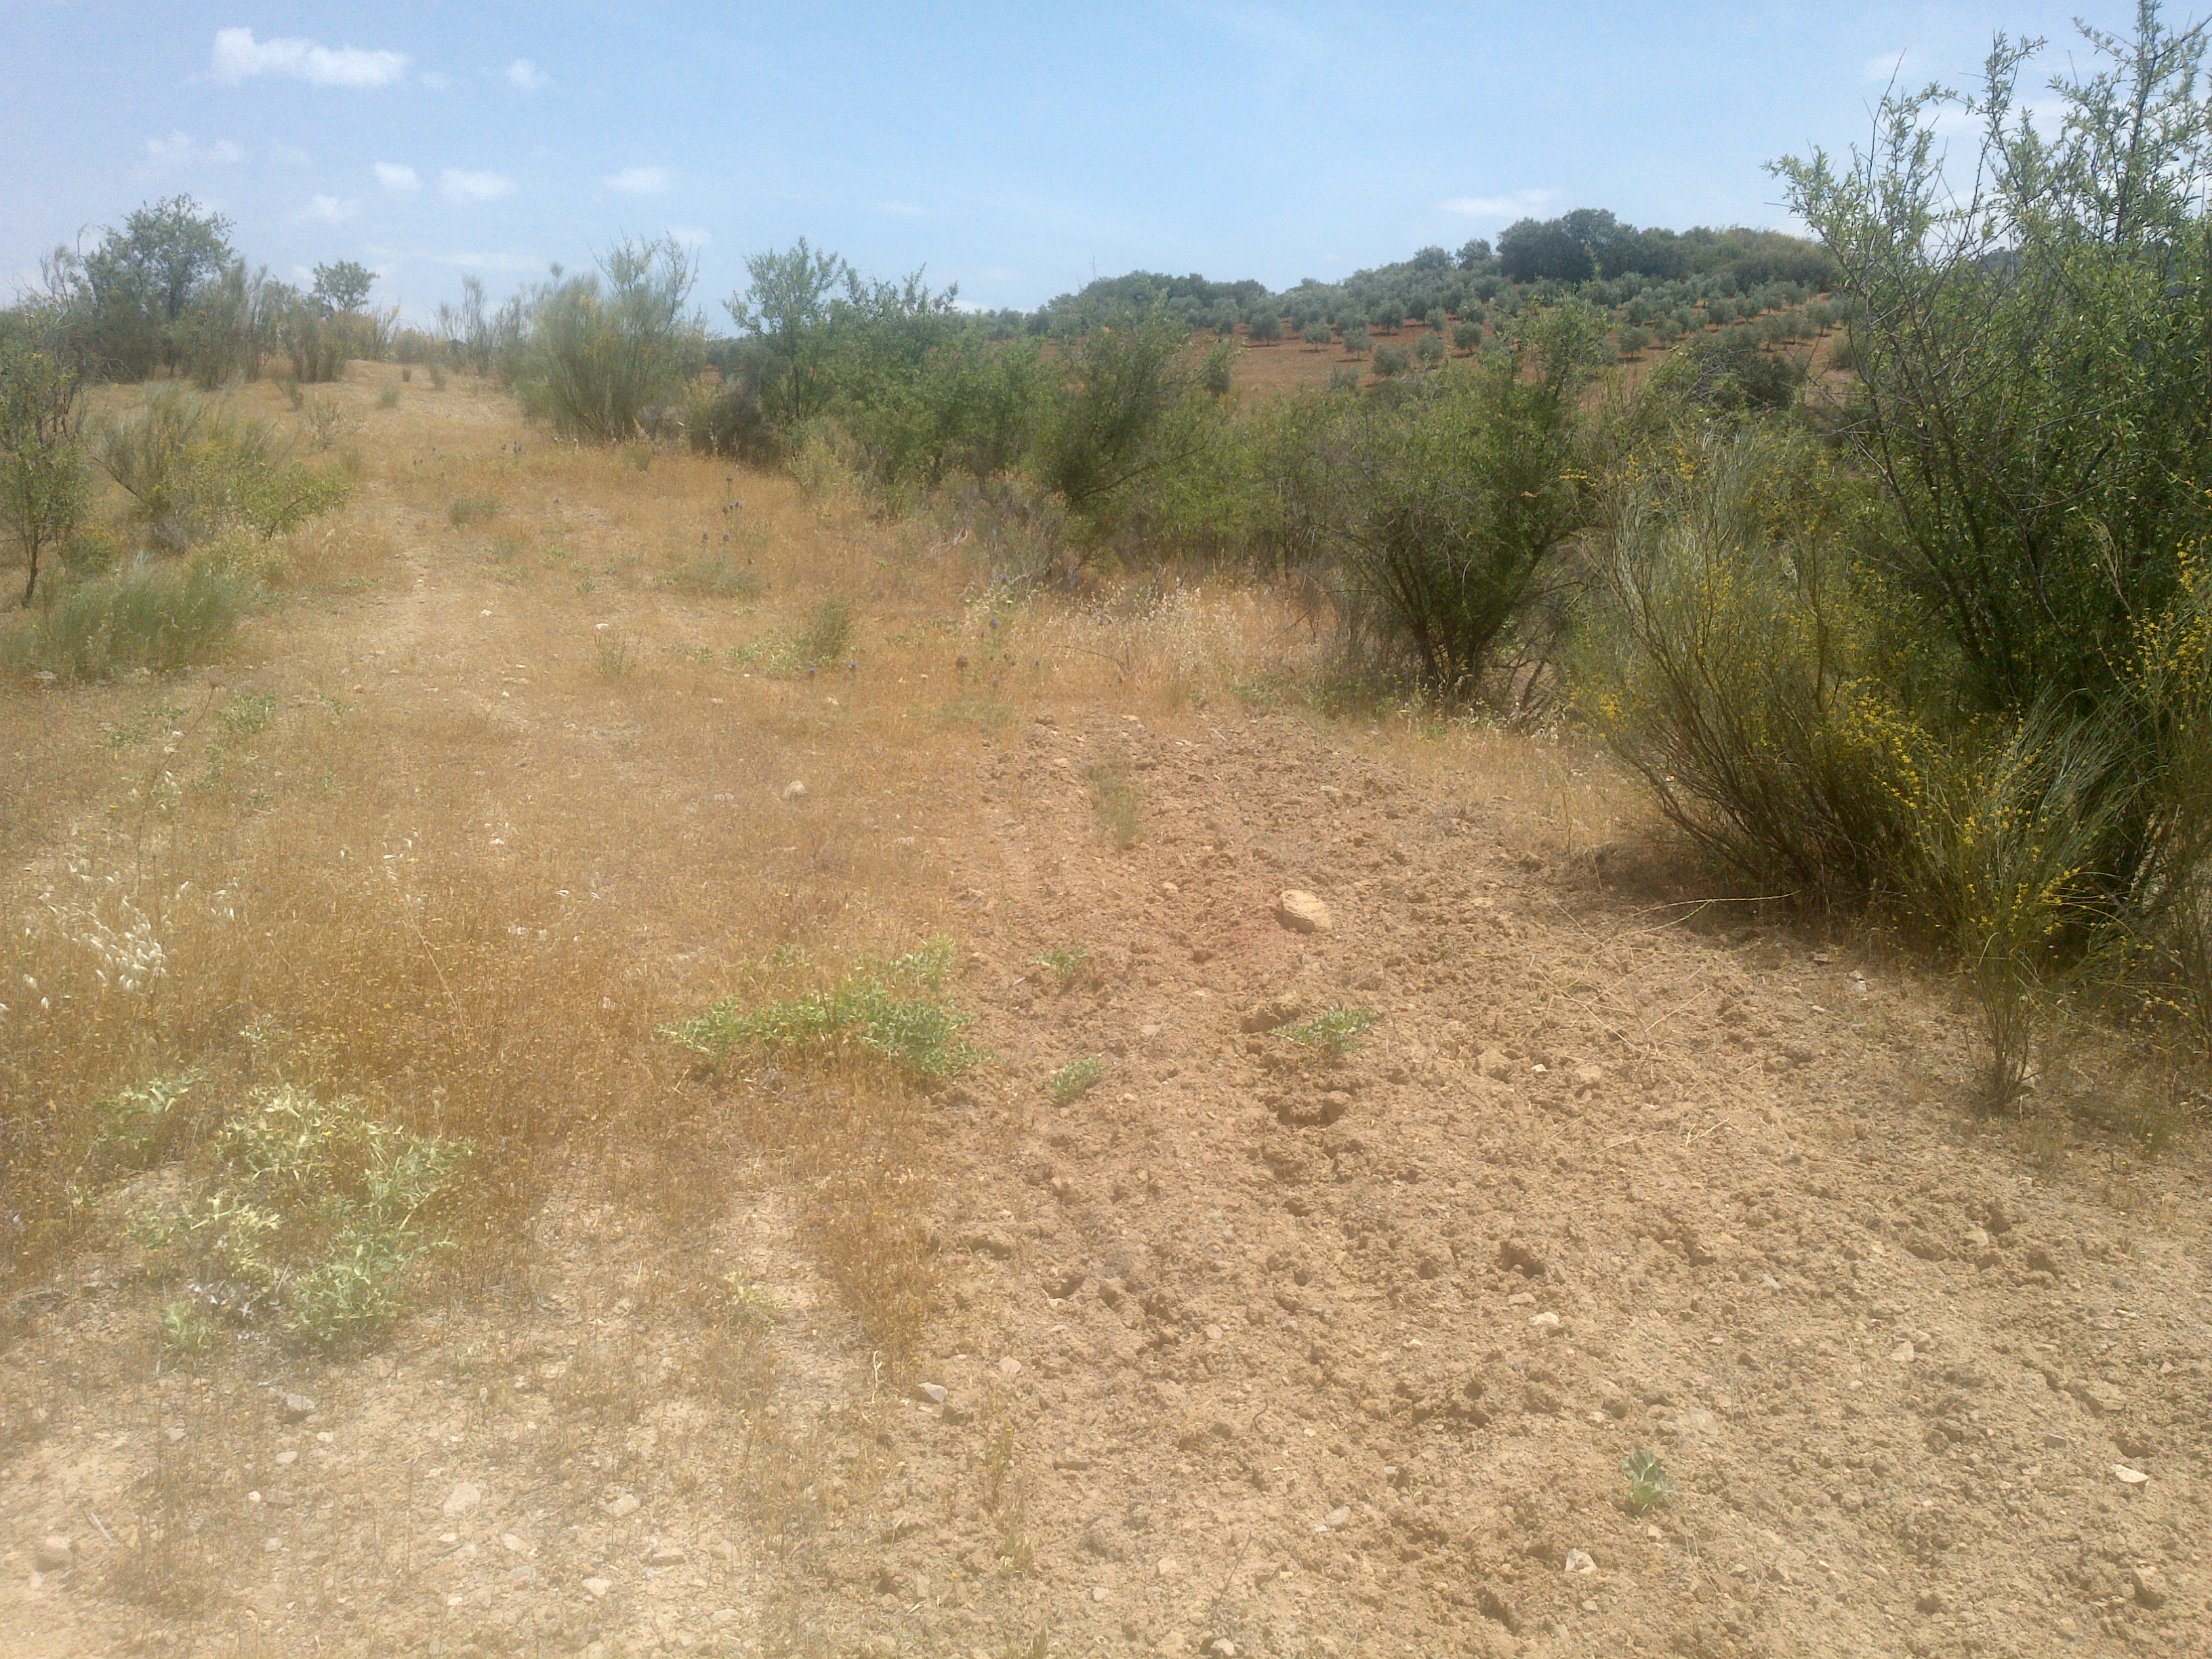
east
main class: Shrubland
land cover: Shrubland without tree cover
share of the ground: 25 - 50 %
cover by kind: herbaceous plants 50 %, shrubs 25 %, unconsolidated bare surface 25 %
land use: Semi-natural and natural areas not in use
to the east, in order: Shrubland without tree cover; Tracks; Shrubland with sparse tree cover; Tracks; Shrubland with sparse tree cover; Broadleaved woodland; Olive groves
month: May
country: ES
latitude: 37.4823
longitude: -4.2159
